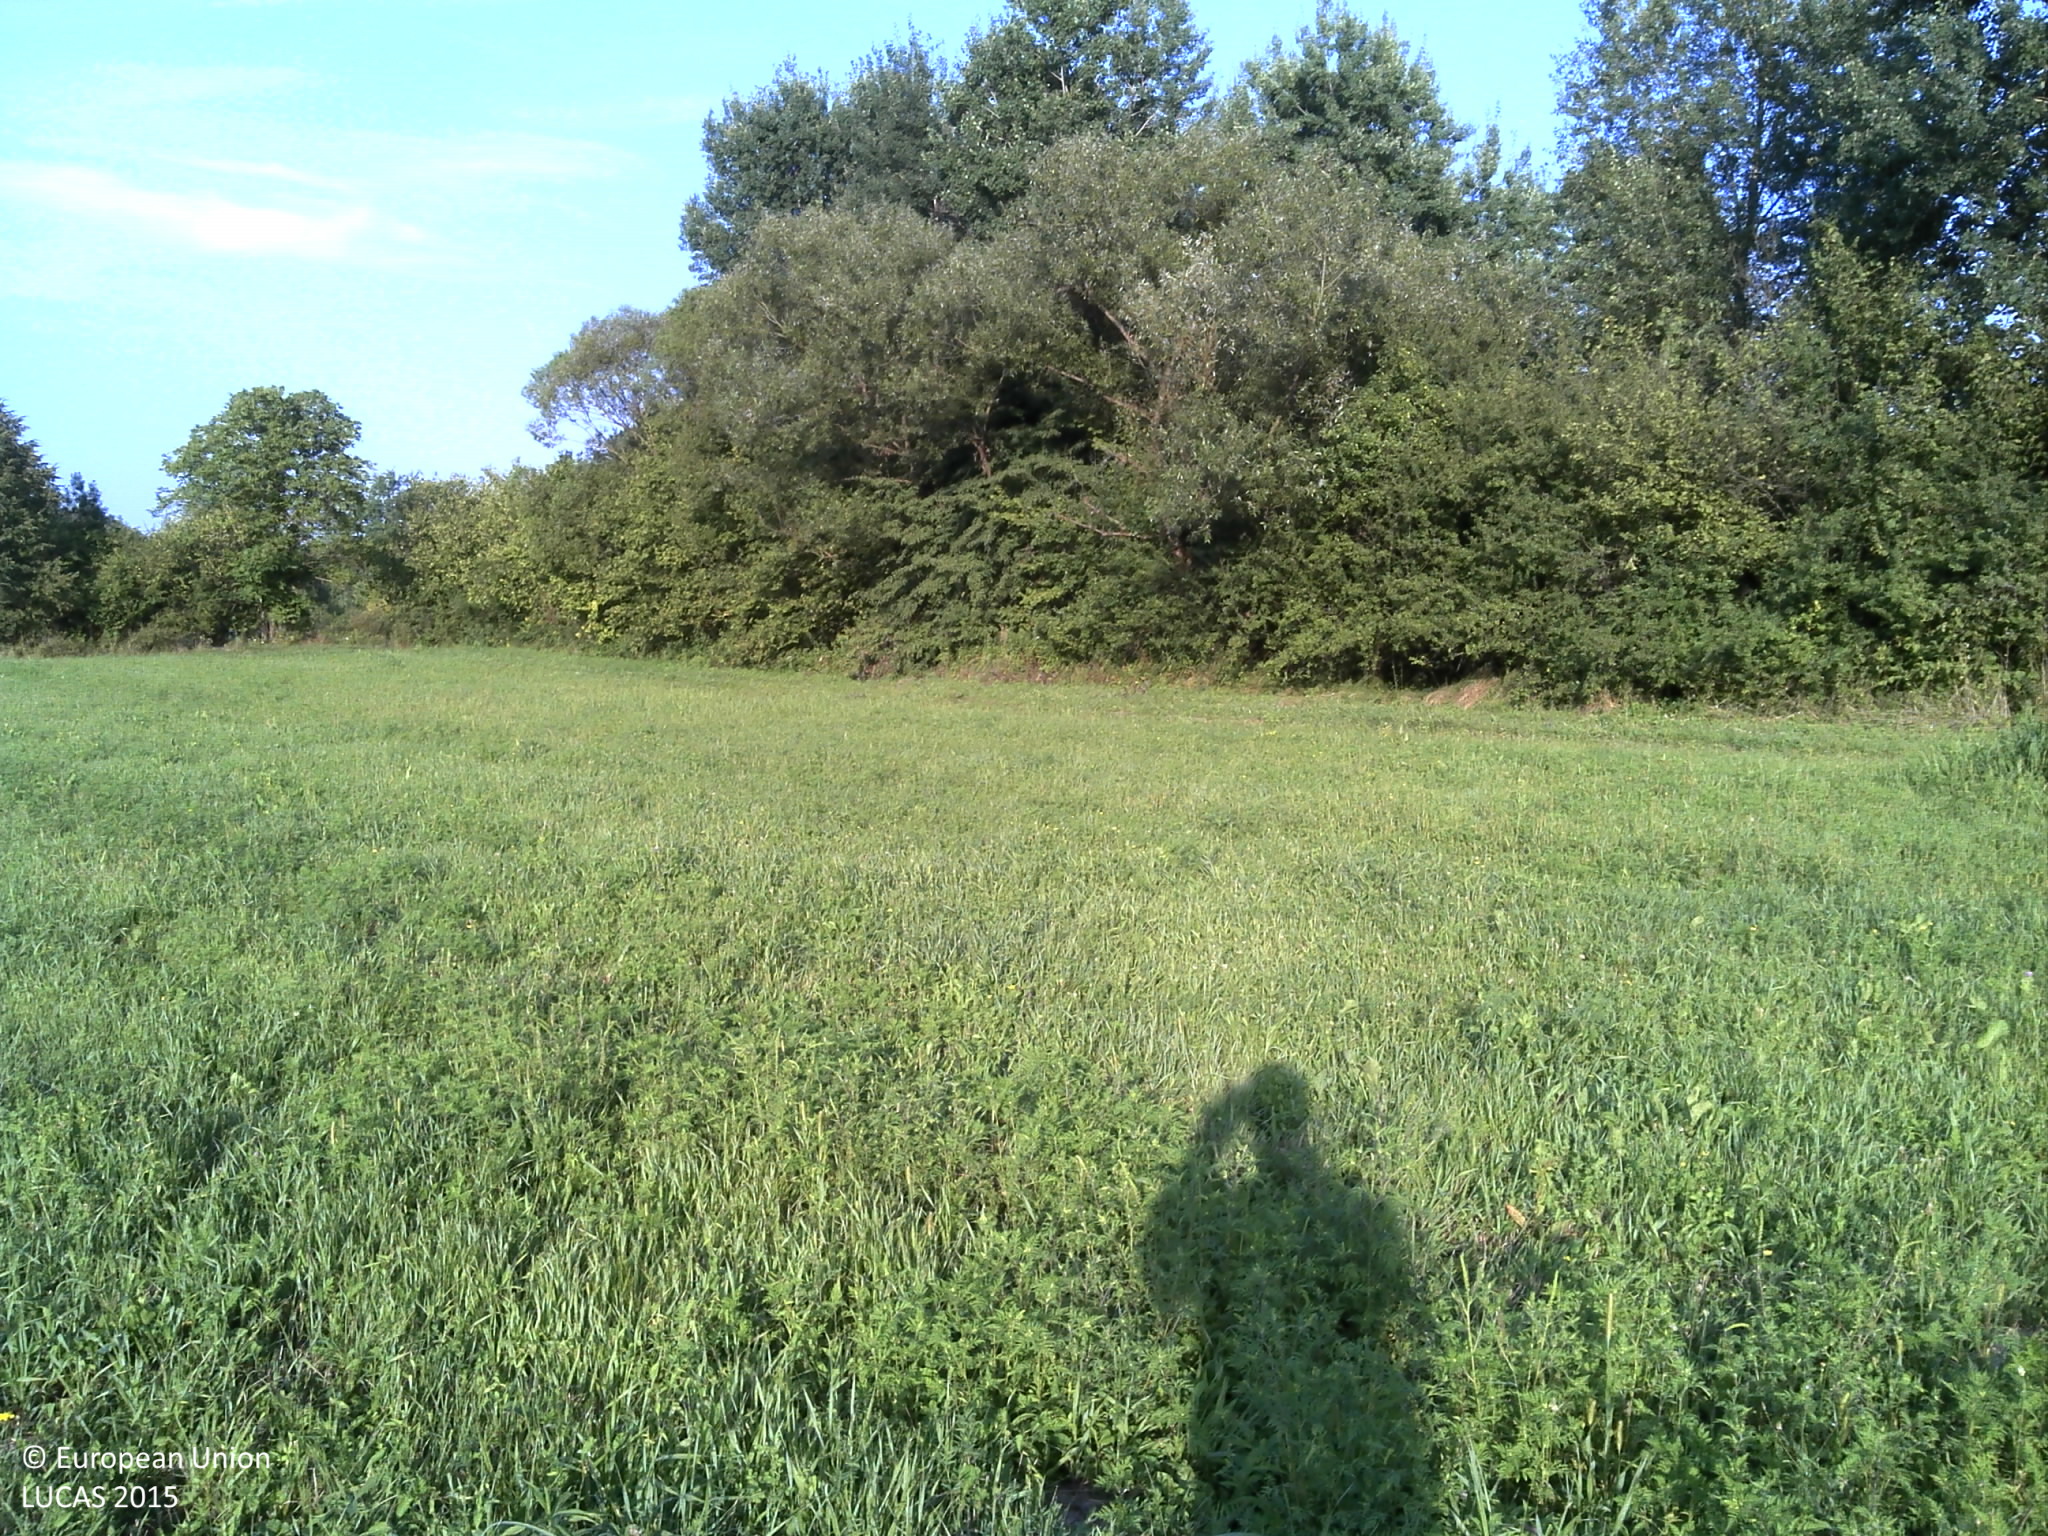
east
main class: Grassland
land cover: Grassland without tree/shrub cover
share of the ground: > 75 %
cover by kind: herbaceous plants 100 %
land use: Semi-natural and natural areas not in use
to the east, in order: Grassland without tree/shrub cover; Shrubland with sparse tree cover; Grassland without tree/shrub cover; Shrubland with sparse tree cover; Grassland without tree/shrub cover; Broadleaved woodland
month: August
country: HR
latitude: 45.2952
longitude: 16.6414
